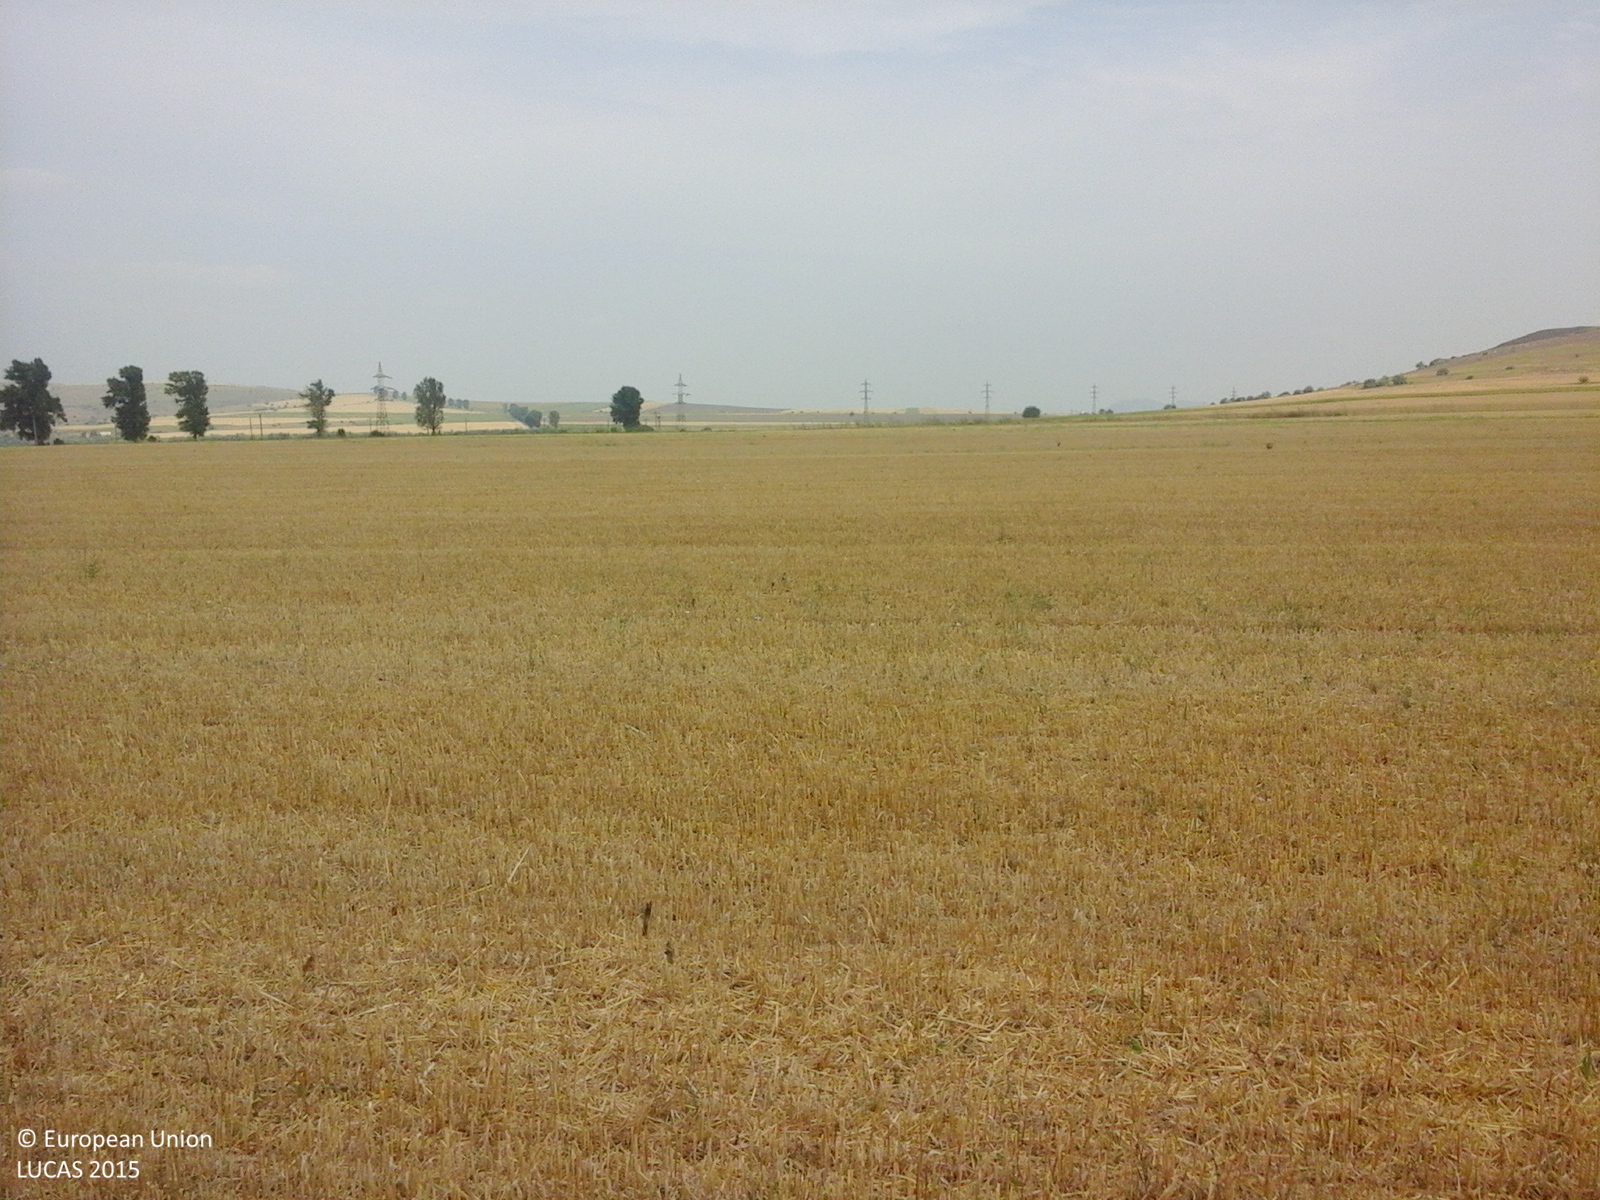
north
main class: Cropland
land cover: Common wheat
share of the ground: > 75 %
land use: Agriculture (excluding fallow land and kitchen gardens)
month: July
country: RO
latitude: 44.9600
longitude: 28.1830
